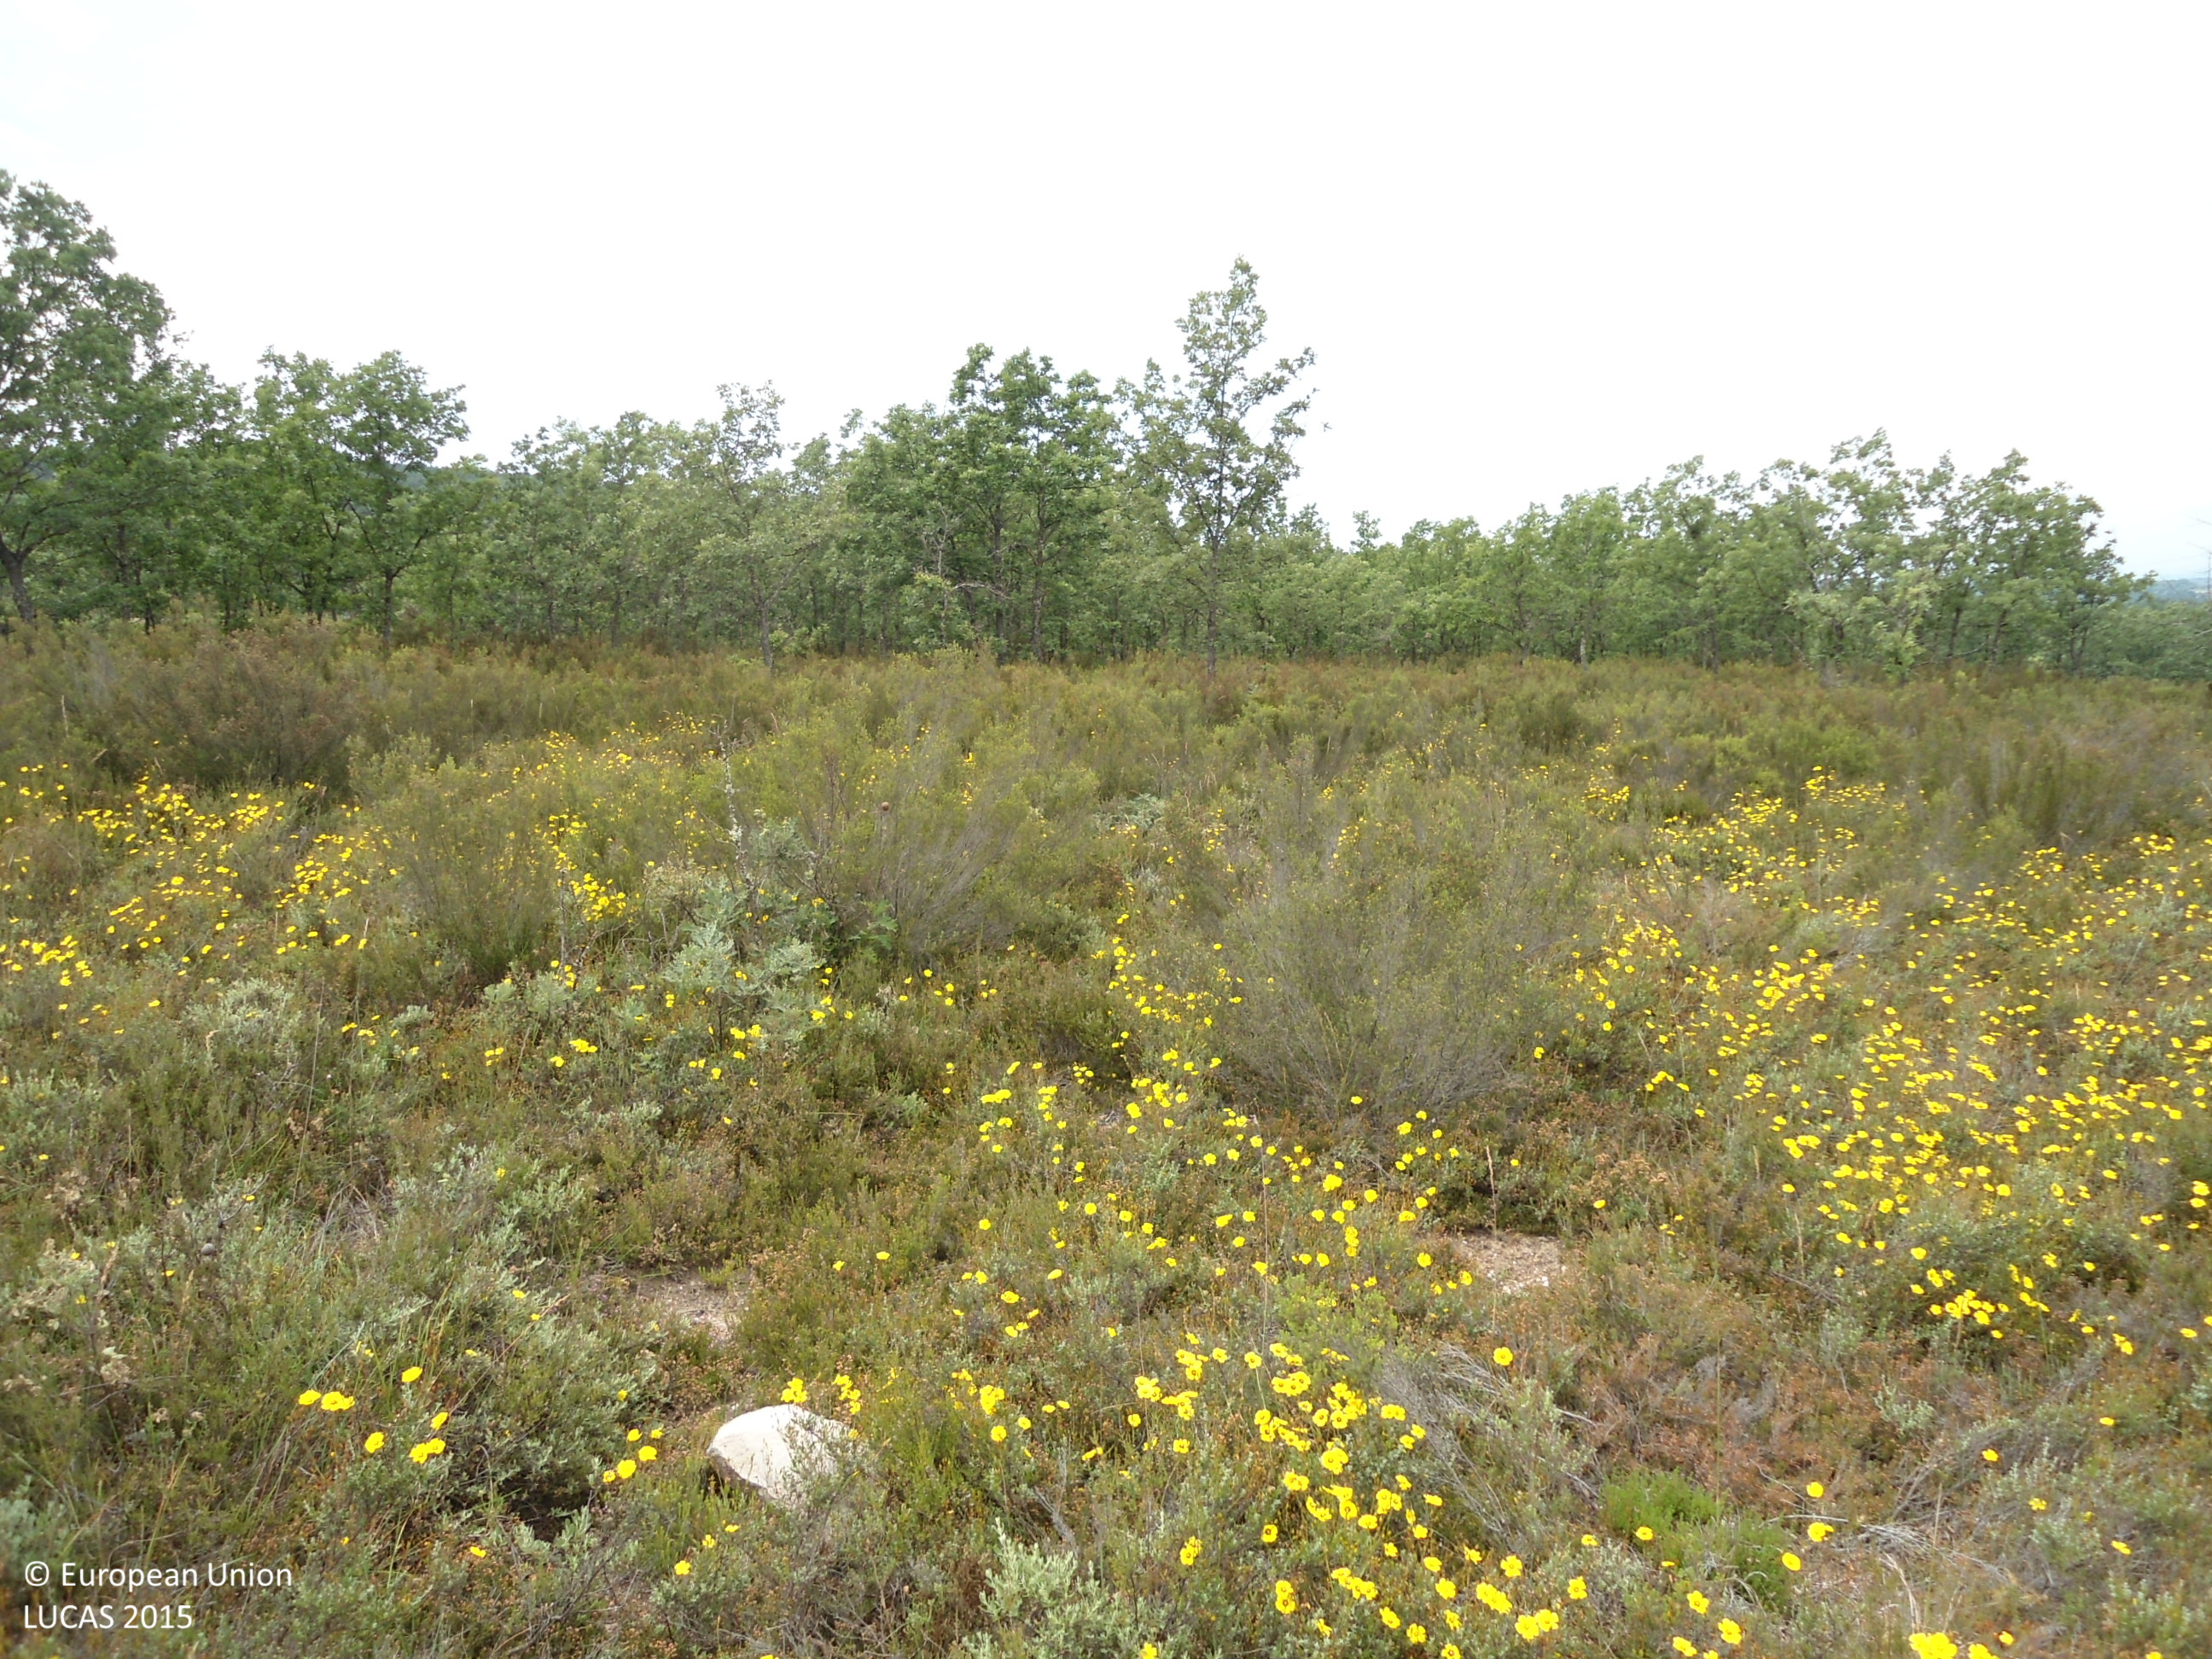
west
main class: Shrubland
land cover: Shrubland with sparse tree cover
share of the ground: > 75 %
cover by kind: shrubs 95 %, broadleaved forest trees 5 %
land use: Semi-natural and natural areas not in use
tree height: < 5 m
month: June
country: ES
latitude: 41.9475
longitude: -6.3051
